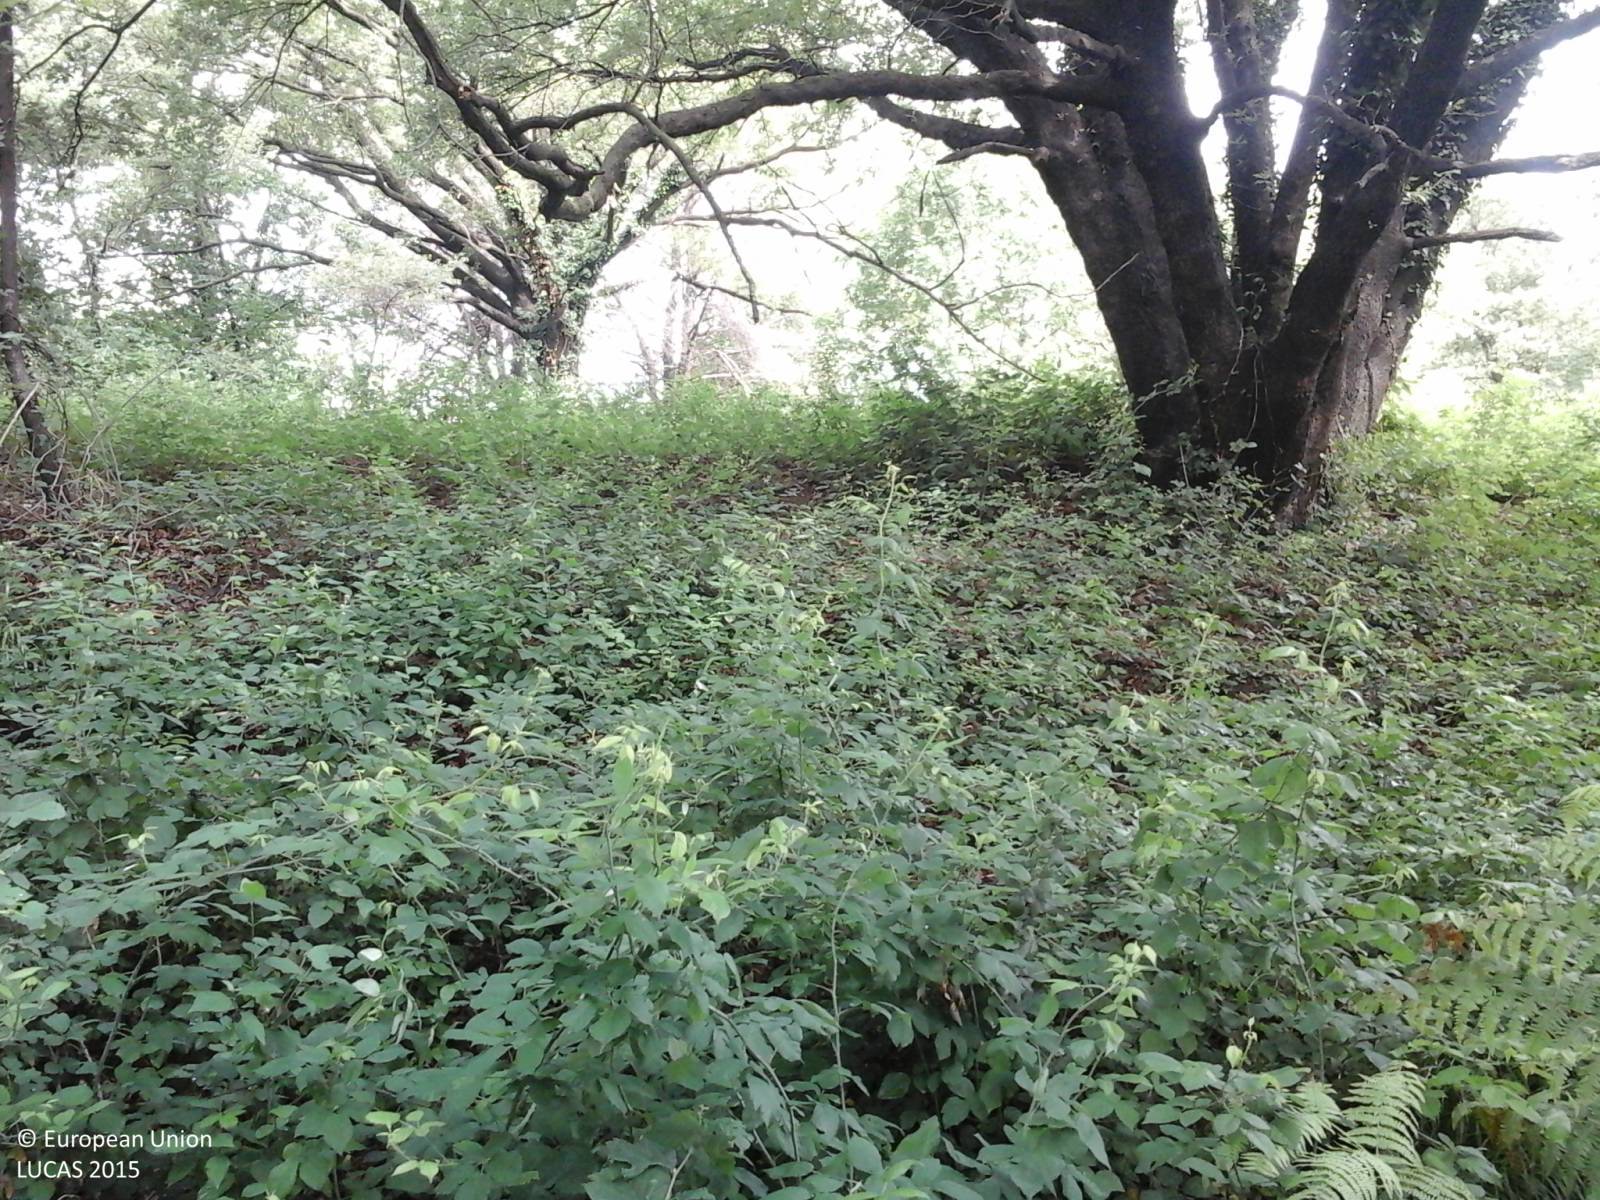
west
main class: Woodland
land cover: Broadleaved woodland
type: thermophilous deciduous forest
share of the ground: > 75 %
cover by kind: broadleaved forest trees 70 %, shrubs 20 %, herbaceous plants 10 %
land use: Forestry
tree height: > 5 m
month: June
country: IT
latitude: 46.1458
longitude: 13.0390
